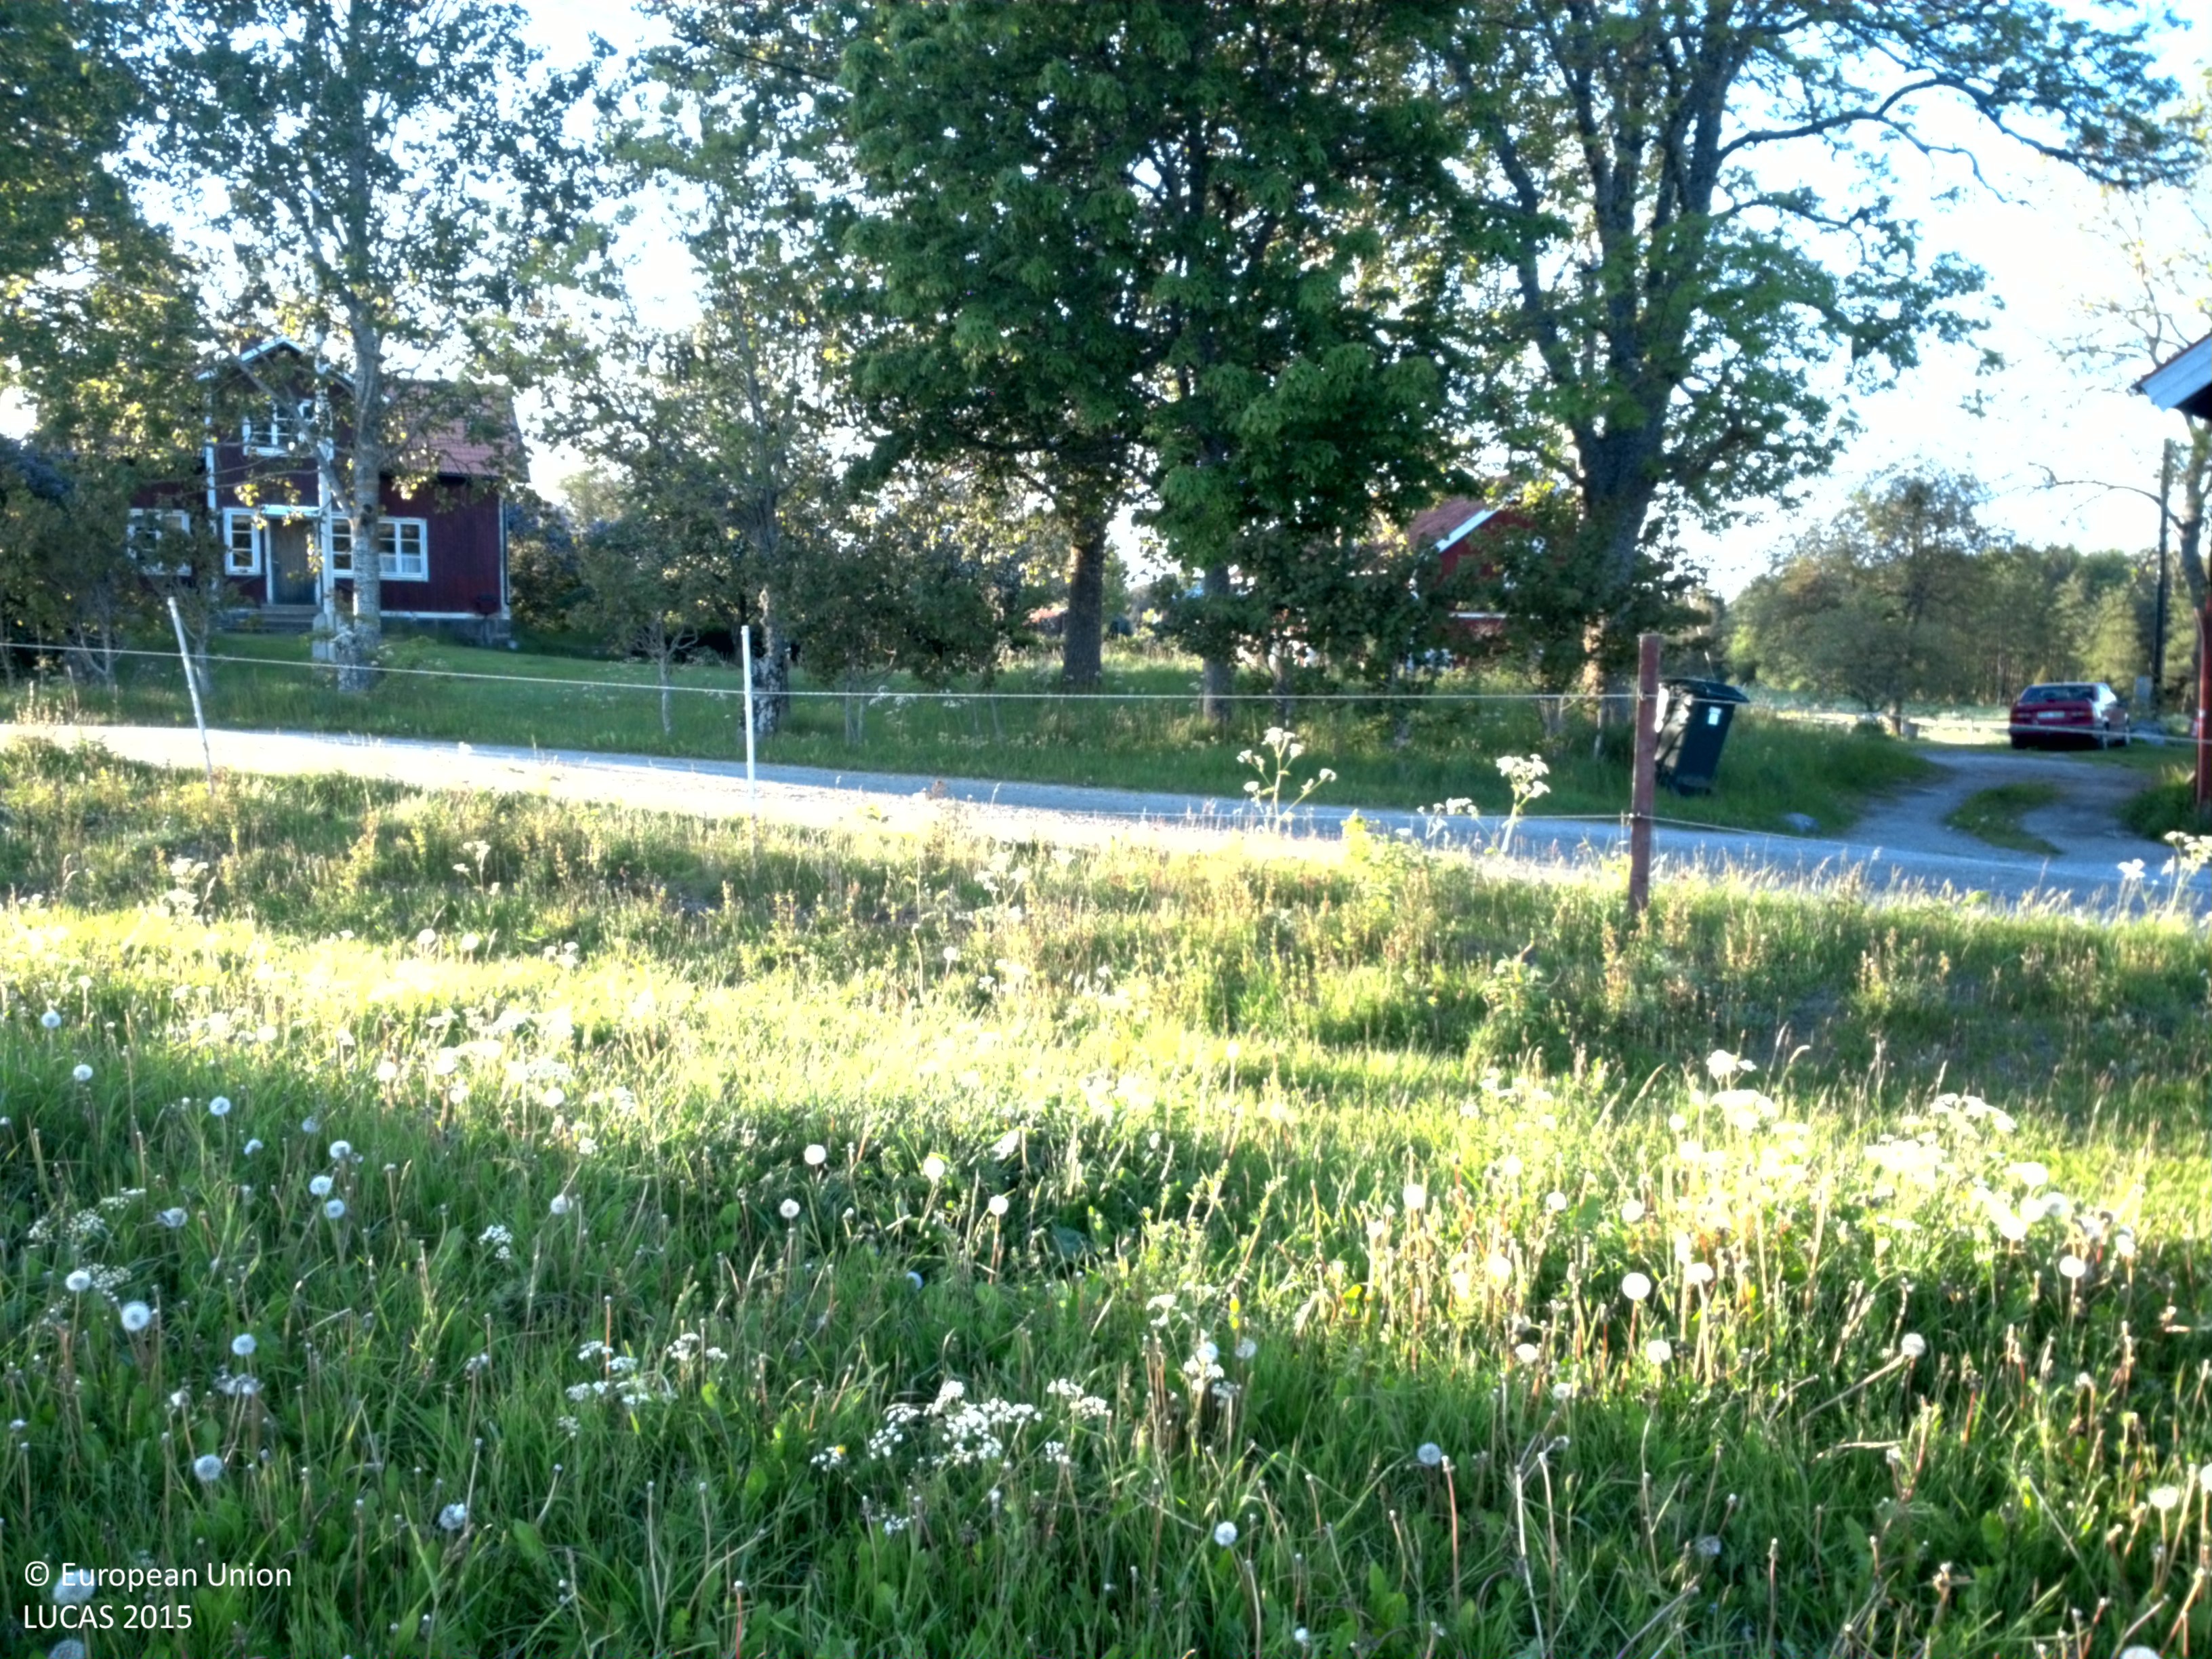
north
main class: Grassland
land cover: Grassland without tree/shrub cover
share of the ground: > 75 %
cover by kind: herbaceous plants 85 %, lichens and mosses 10 %, shrubs 5 %
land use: Agriculture (excluding fallow land and kitchen gardens)
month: June
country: SE
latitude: 60.1609
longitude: 18.7729
